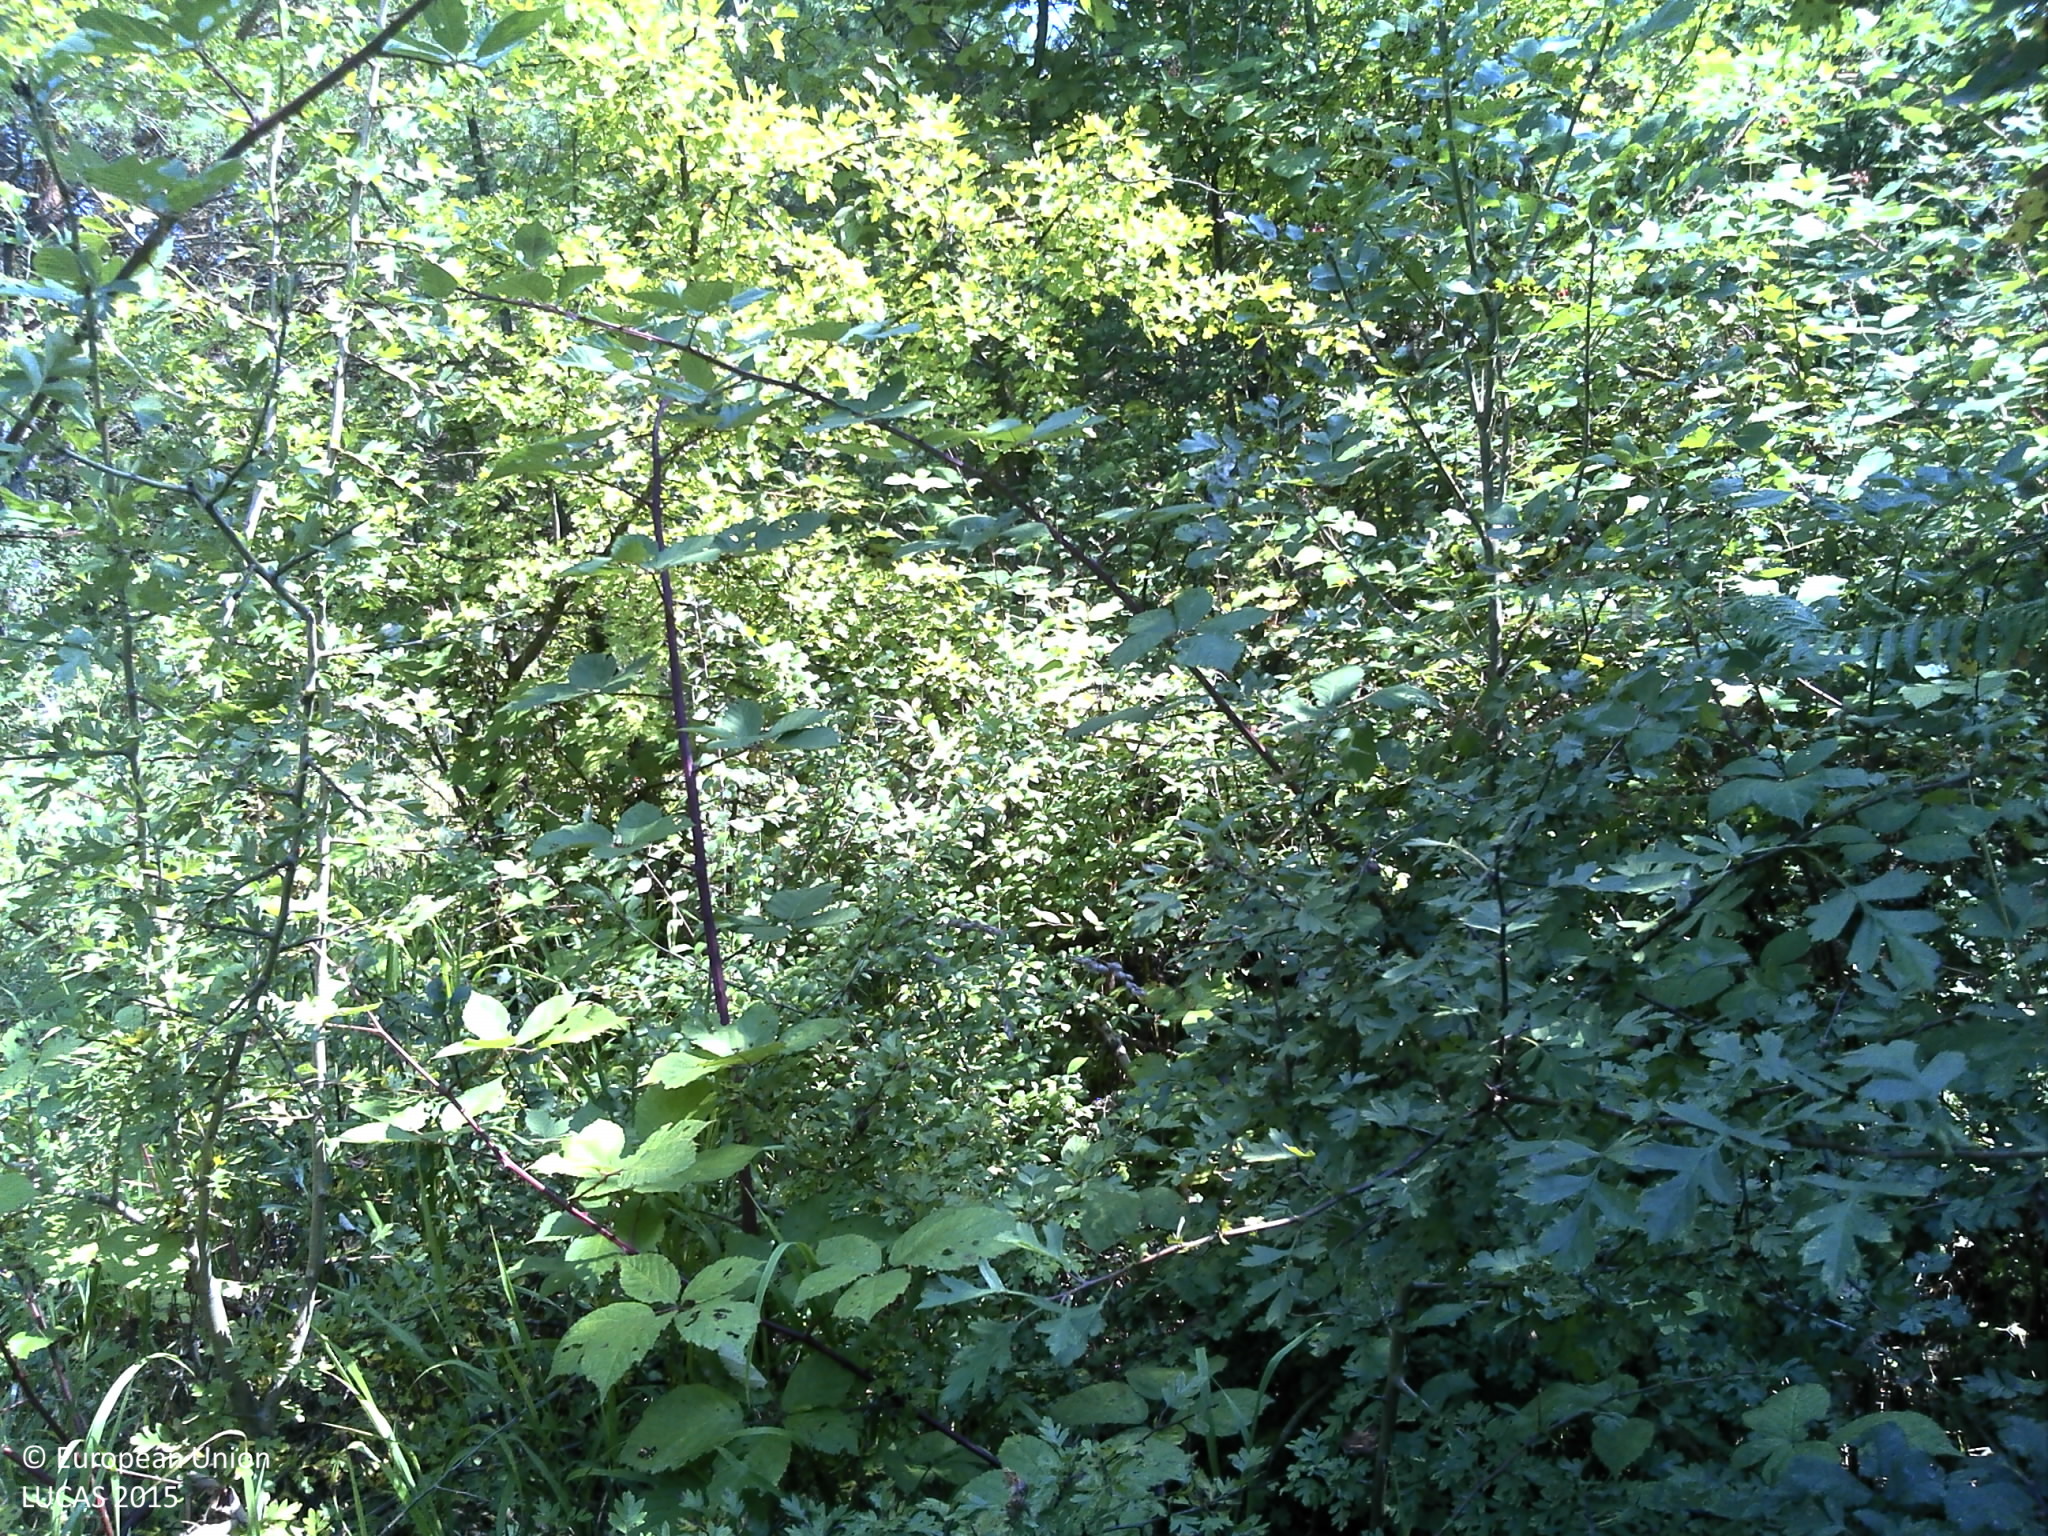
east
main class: Woodland
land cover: Broadleaved woodland
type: acidophilous oak and oak-birch forest
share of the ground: > 75 %
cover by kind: broadleaved forest trees 100 %
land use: Forestry
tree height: > 5 m
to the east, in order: Broadleaved woodland
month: August
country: HR
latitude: 45.1465
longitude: 16.1137
